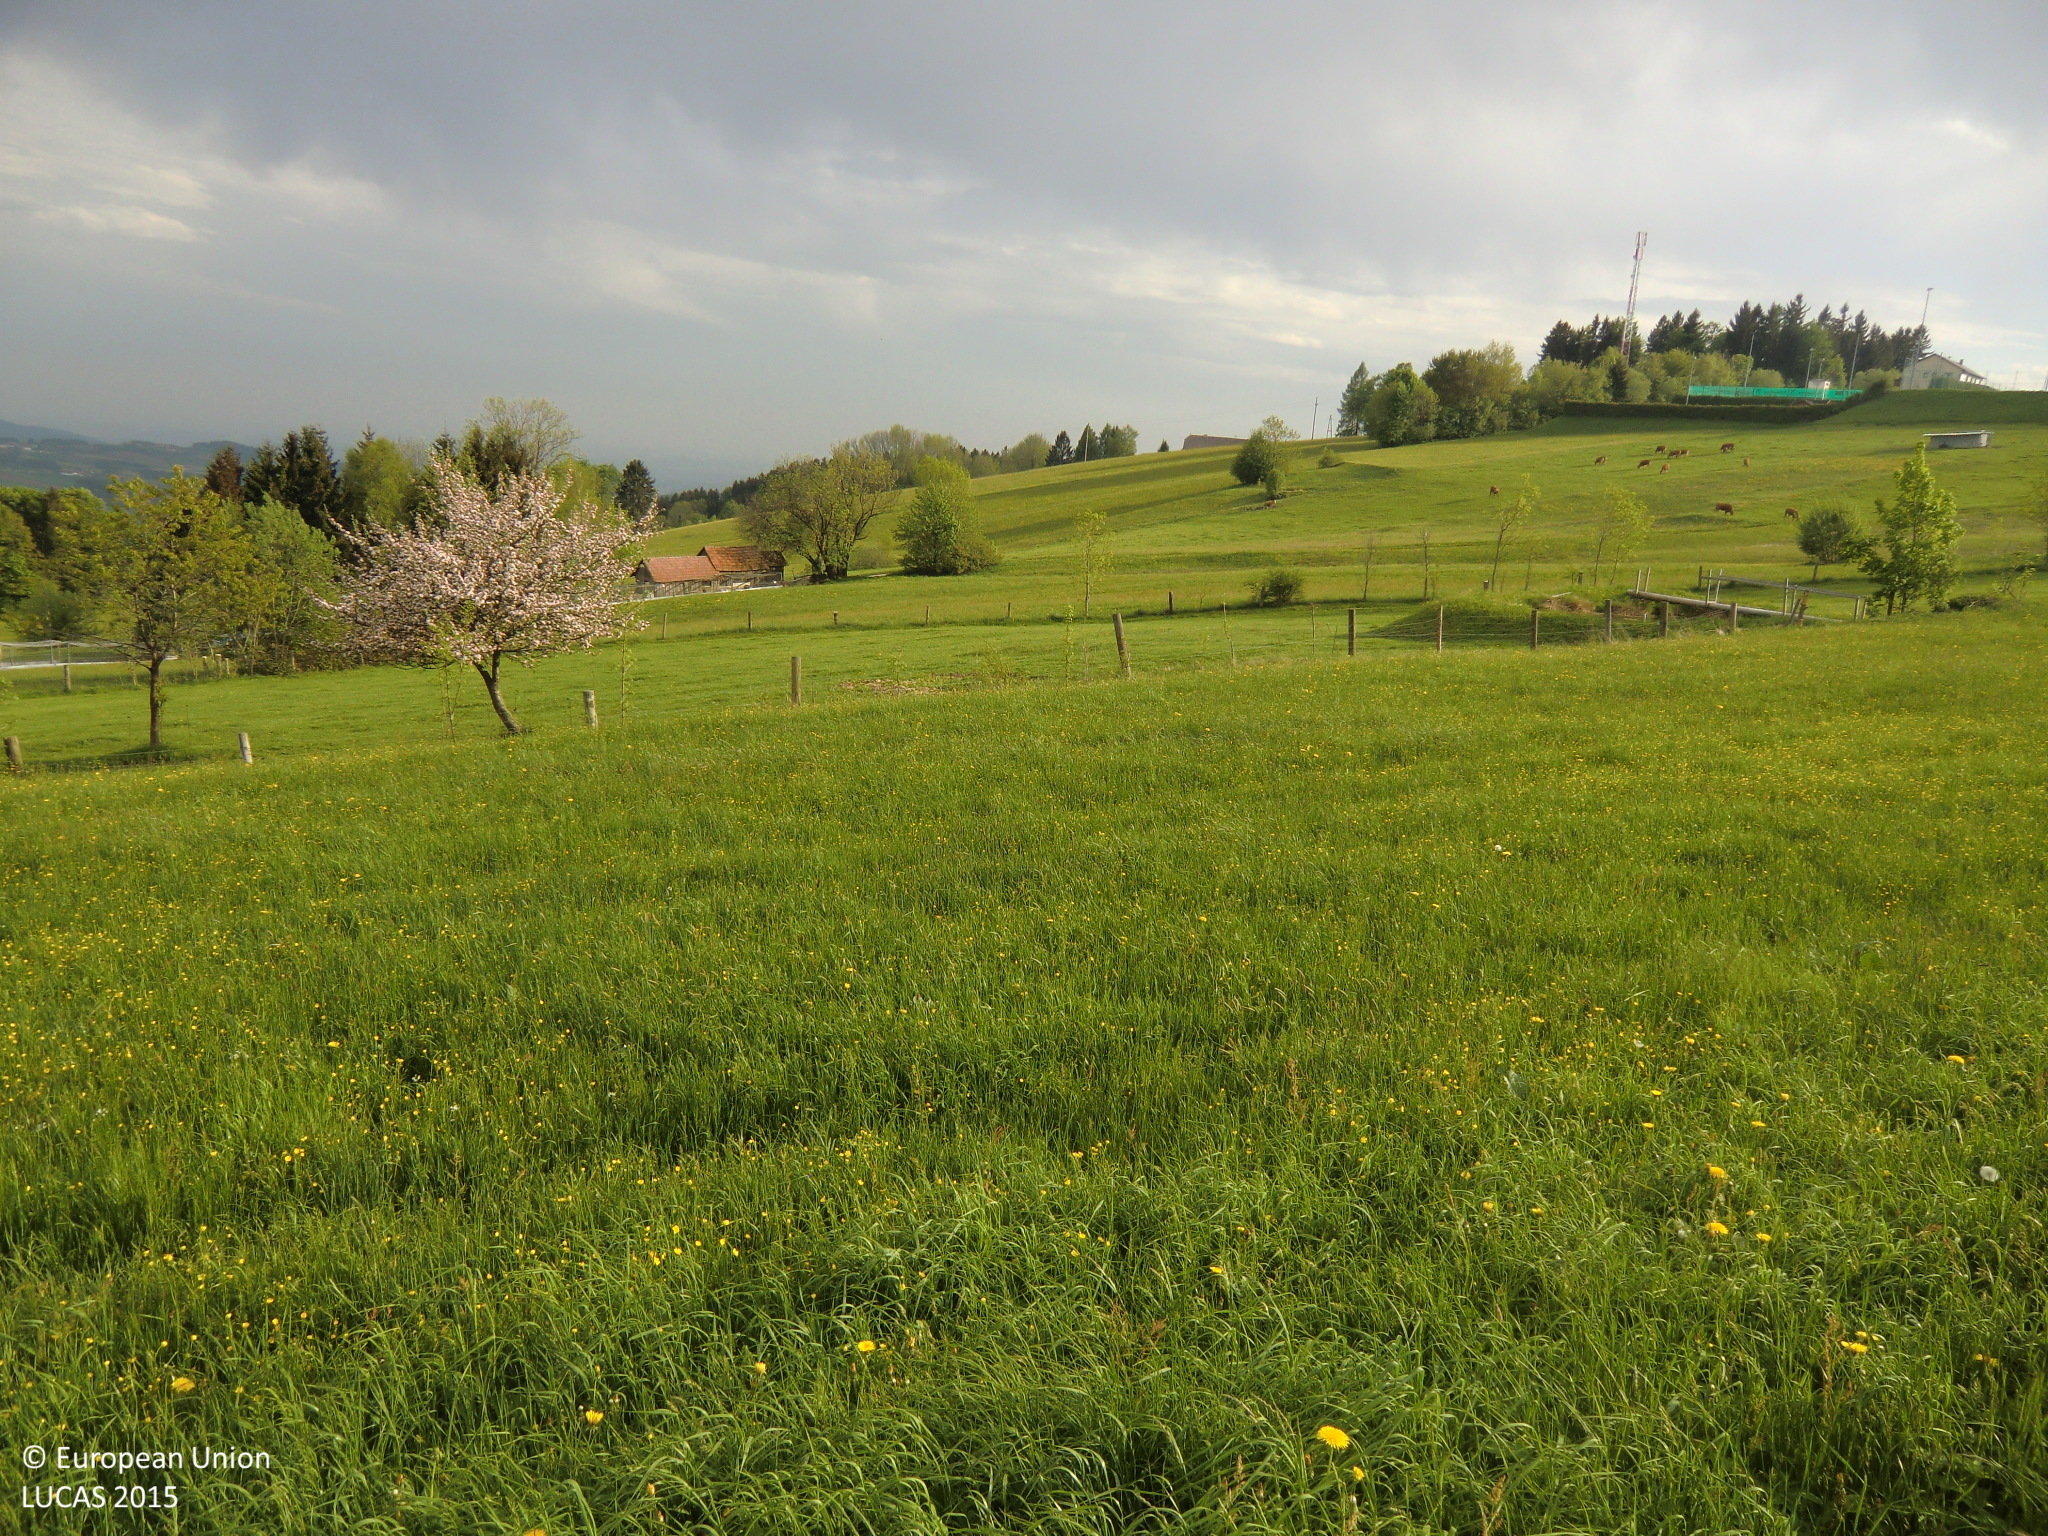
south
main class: Grassland
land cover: Grassland without tree/shrub cover
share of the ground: > 75 %
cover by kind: herbaceous plants 100 %
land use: Agriculture (excluding fallow land and kitchen gardens)
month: May
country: AT
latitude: 48.4106
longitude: 14.2829
